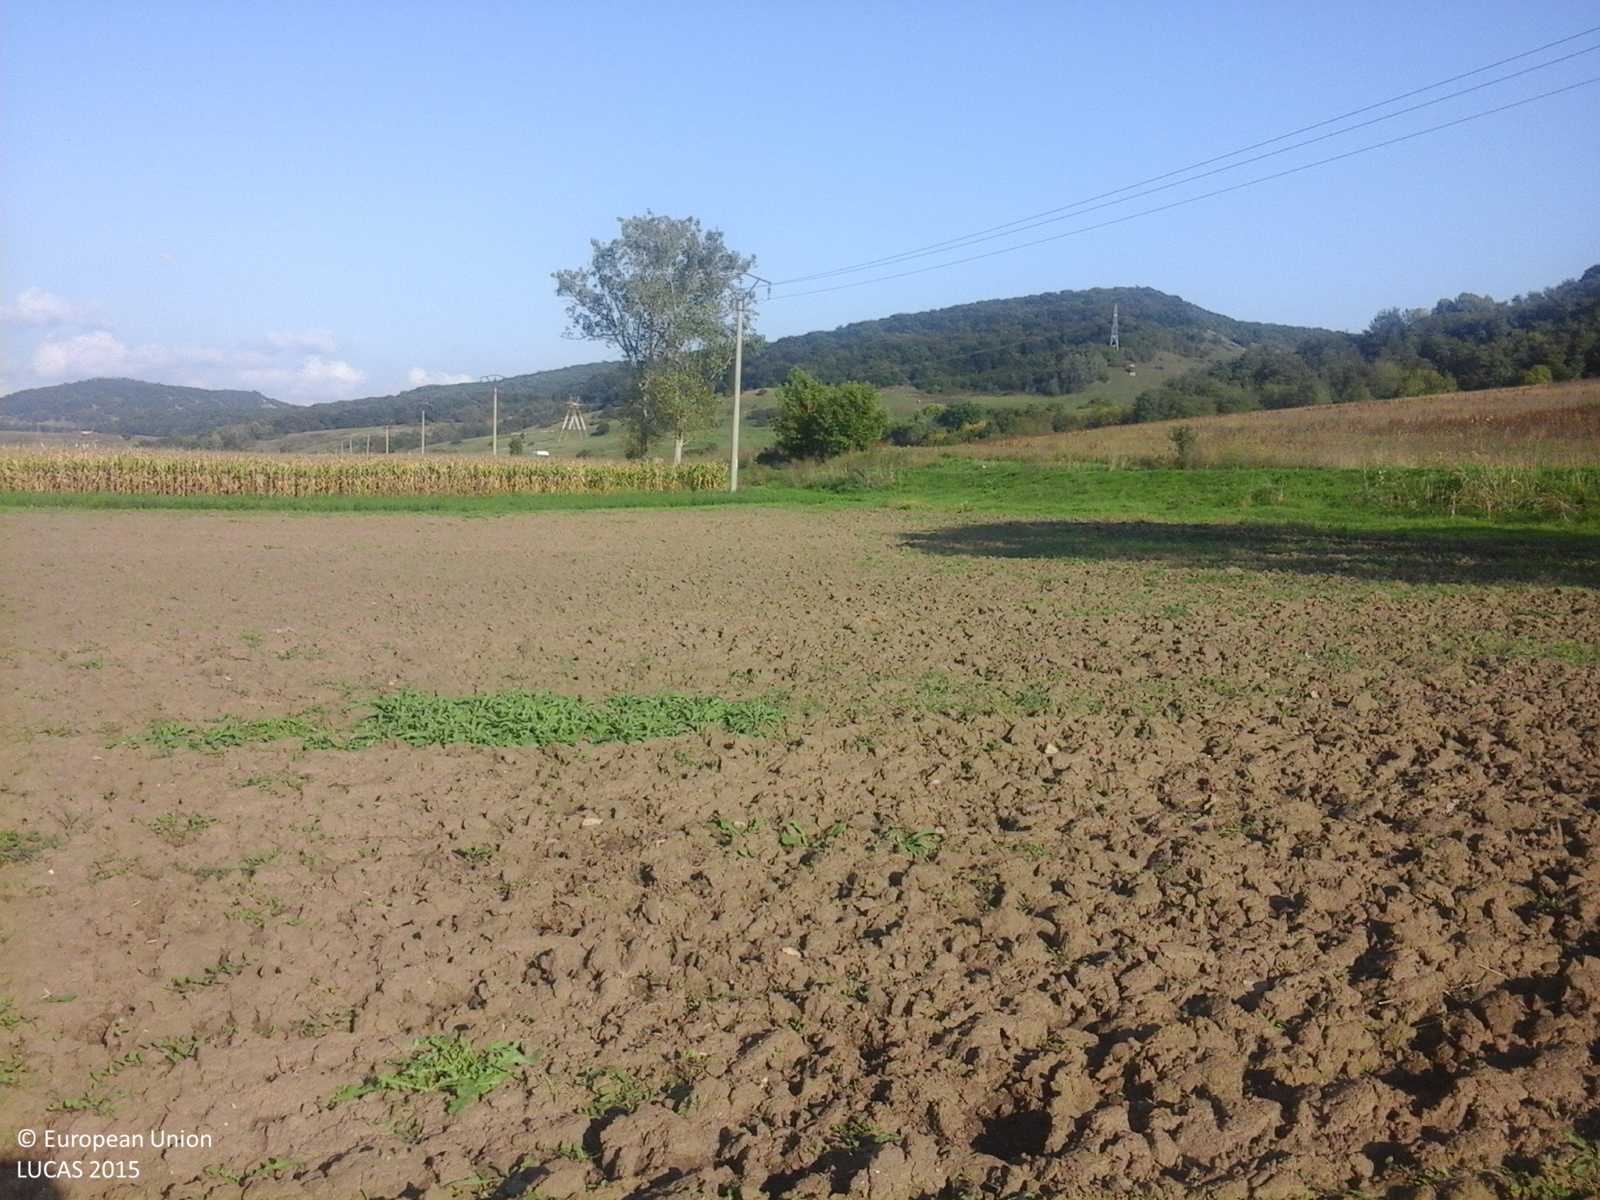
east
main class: Grassland
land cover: Spontaneously vegetated surfaces
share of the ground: > 75 %
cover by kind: herbaceous plants 100 %
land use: Agriculture (excluding fallow land and kitchen gardens)
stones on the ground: < 10 %
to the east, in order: Spontaneously vegetated surfaces; Electric lines; Grassland without tree/shrub cover; Paved roads, cycling and walking lanes; Grass margins; Soya
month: October
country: RO
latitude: 46.0831
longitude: 24.1335
